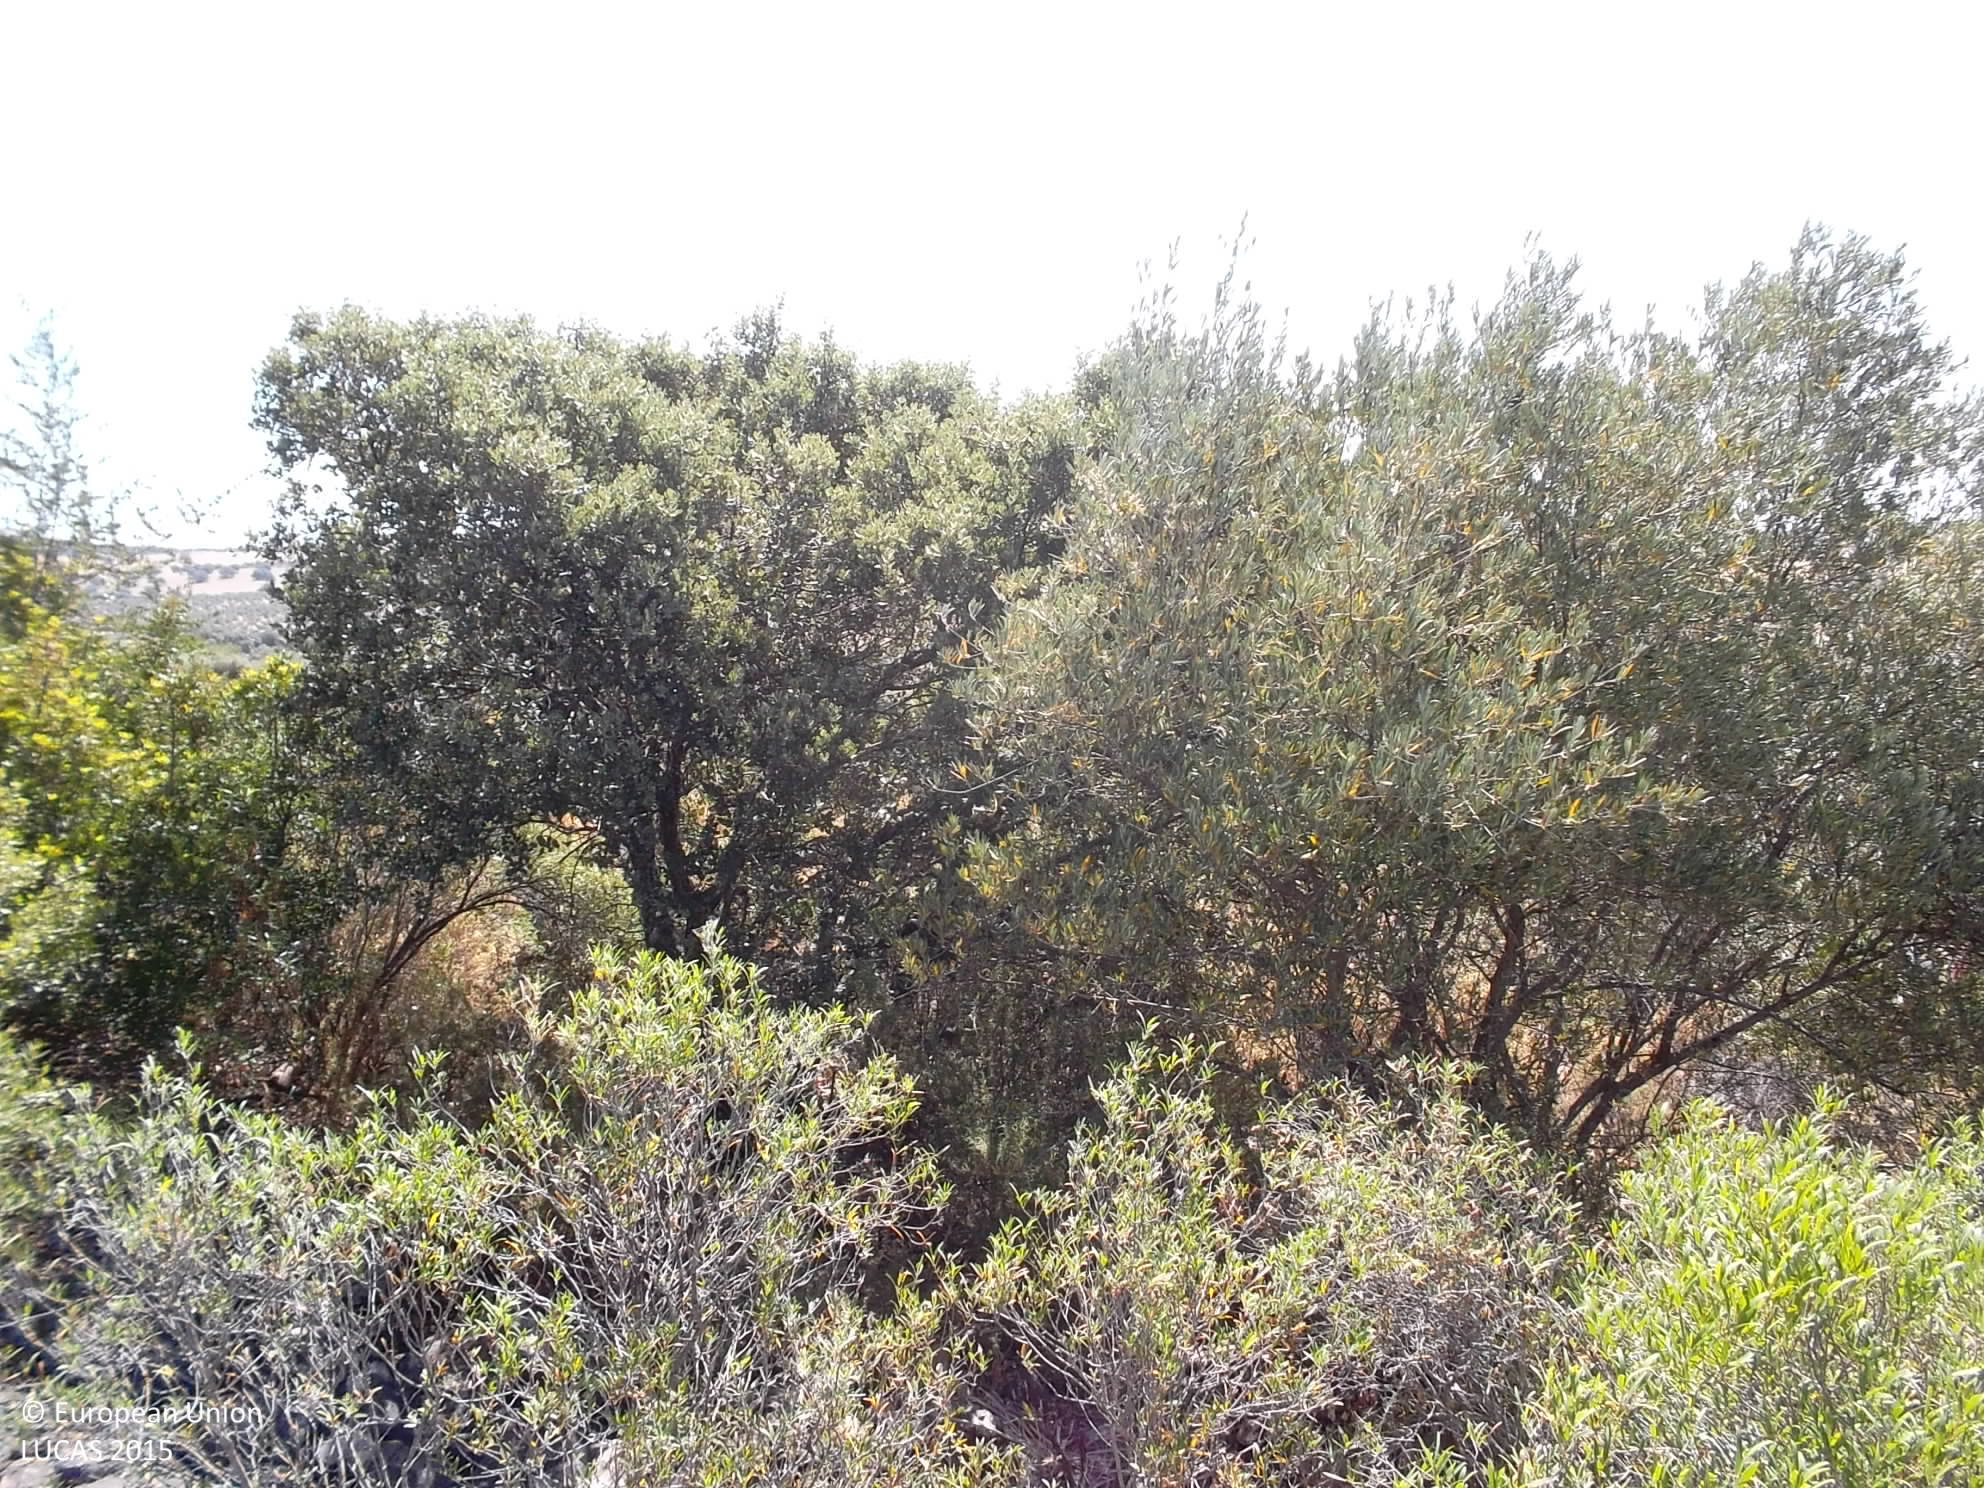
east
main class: Woodland
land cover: Broadleaved woodland
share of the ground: 25 - 50 %
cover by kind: shrubs 50 %, broadleaved forest trees 40 %, unconsolidated bare surface 10 %
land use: Forestry
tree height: < 5 m
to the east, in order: Broadleaved woodland; Fences; Tracks; Broadleaved woodland; Fences; Abandoned hedges; Tracks; Olive groves
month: June
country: ES
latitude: 39.0406
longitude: -4.1071
